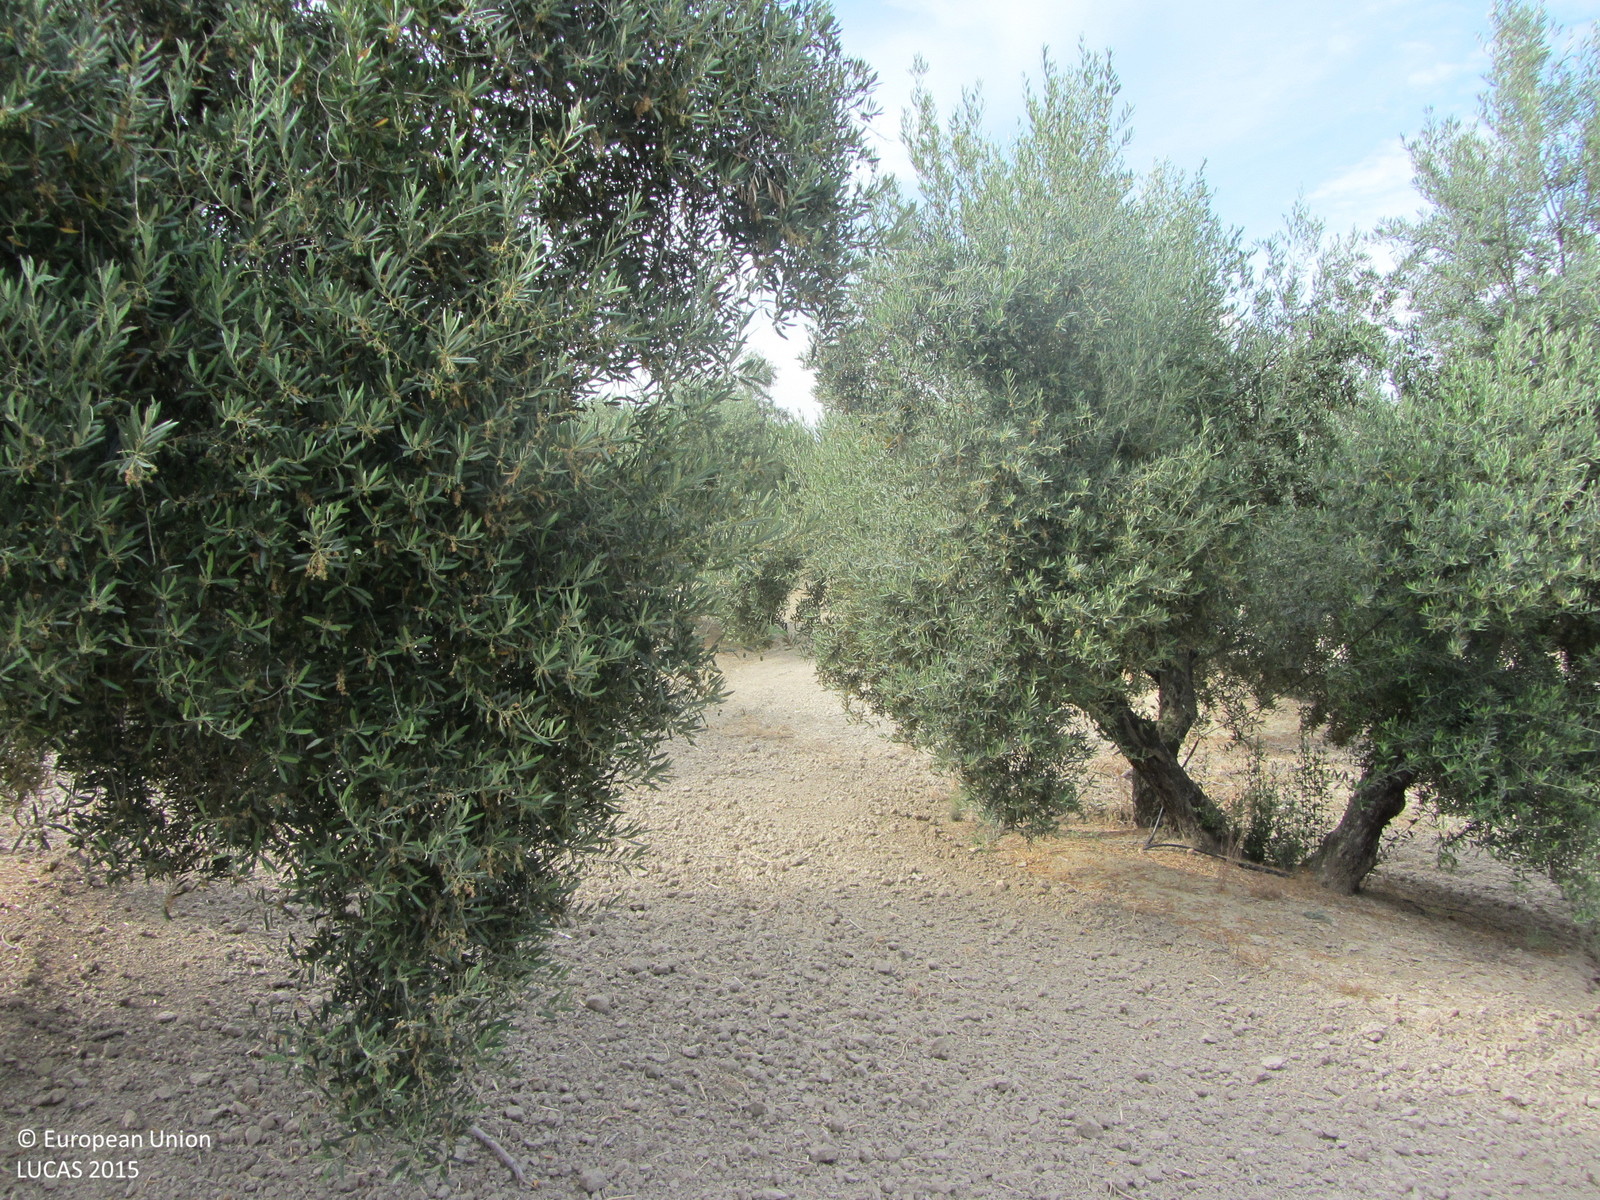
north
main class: Cropland
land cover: Olive groves
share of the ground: 25 - 50 %
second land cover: Other bare soil
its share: > 75 %
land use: Agriculture (excluding fallow land and kitchen gardens)
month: June
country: ES
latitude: 37.9913
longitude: -3.2411
